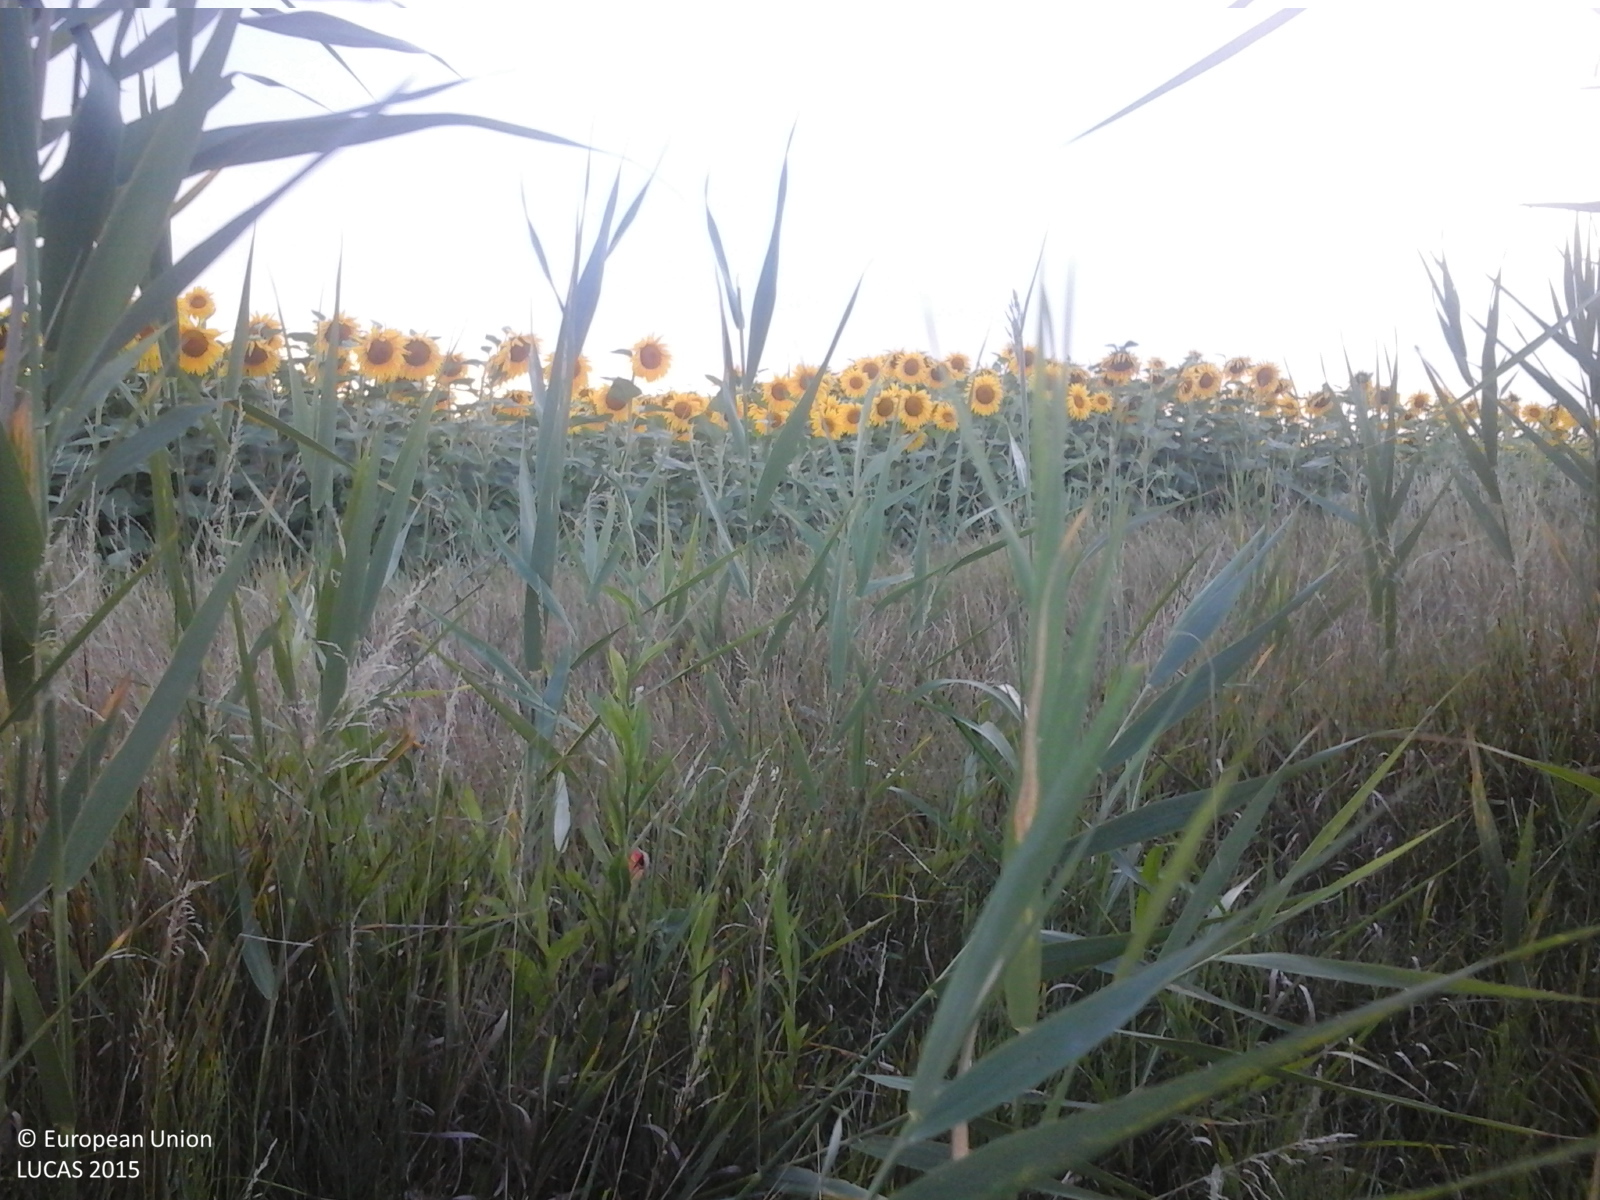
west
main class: Grassland
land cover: Spontaneously vegetated surfaces
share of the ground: 50 - 75 %
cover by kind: herbaceous plants 100 %
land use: Agriculture (excluding fallow land and kitchen gardens)
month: July
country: RO
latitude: 43.8484
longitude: 24.6847
